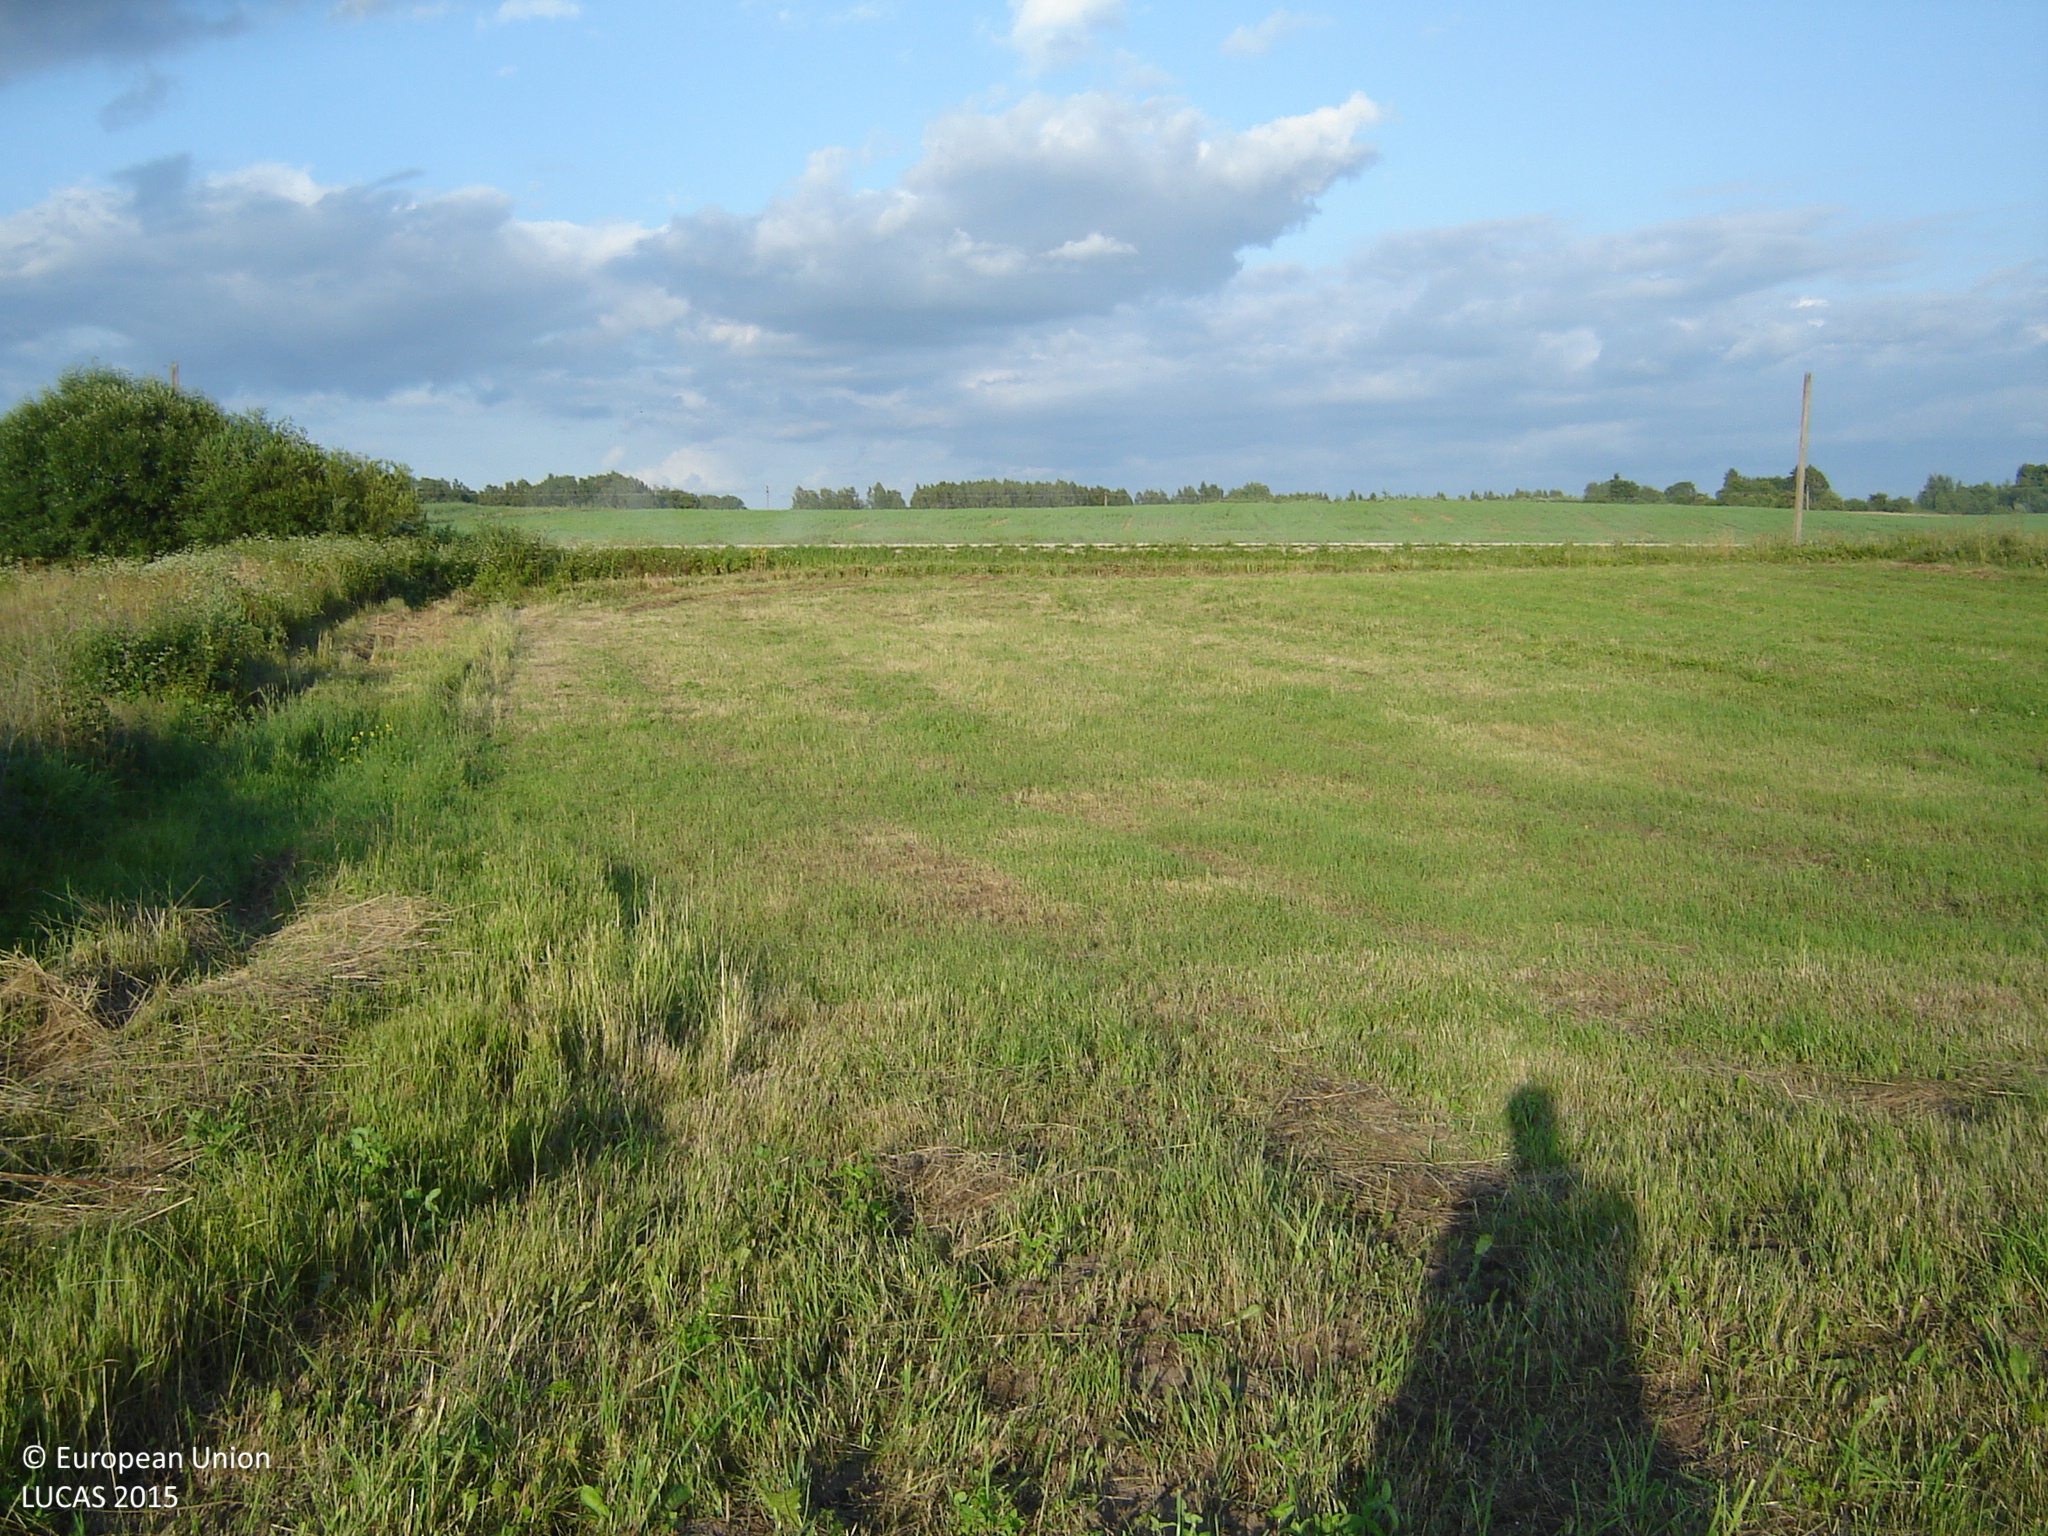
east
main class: Grassland
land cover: Grassland without tree/shrub cover
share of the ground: > 75 %
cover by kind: herbaceous plants 100 %
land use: Agriculture (excluding fallow land and kitchen gardens)
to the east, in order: Grassland without tree/shrub cover; Paved roads, cycling and walking lanes; Grass margins; Dry pulses; Spontaneously vegetated surfaces
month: July
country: LT
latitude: 55.4706
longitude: 25.0947
